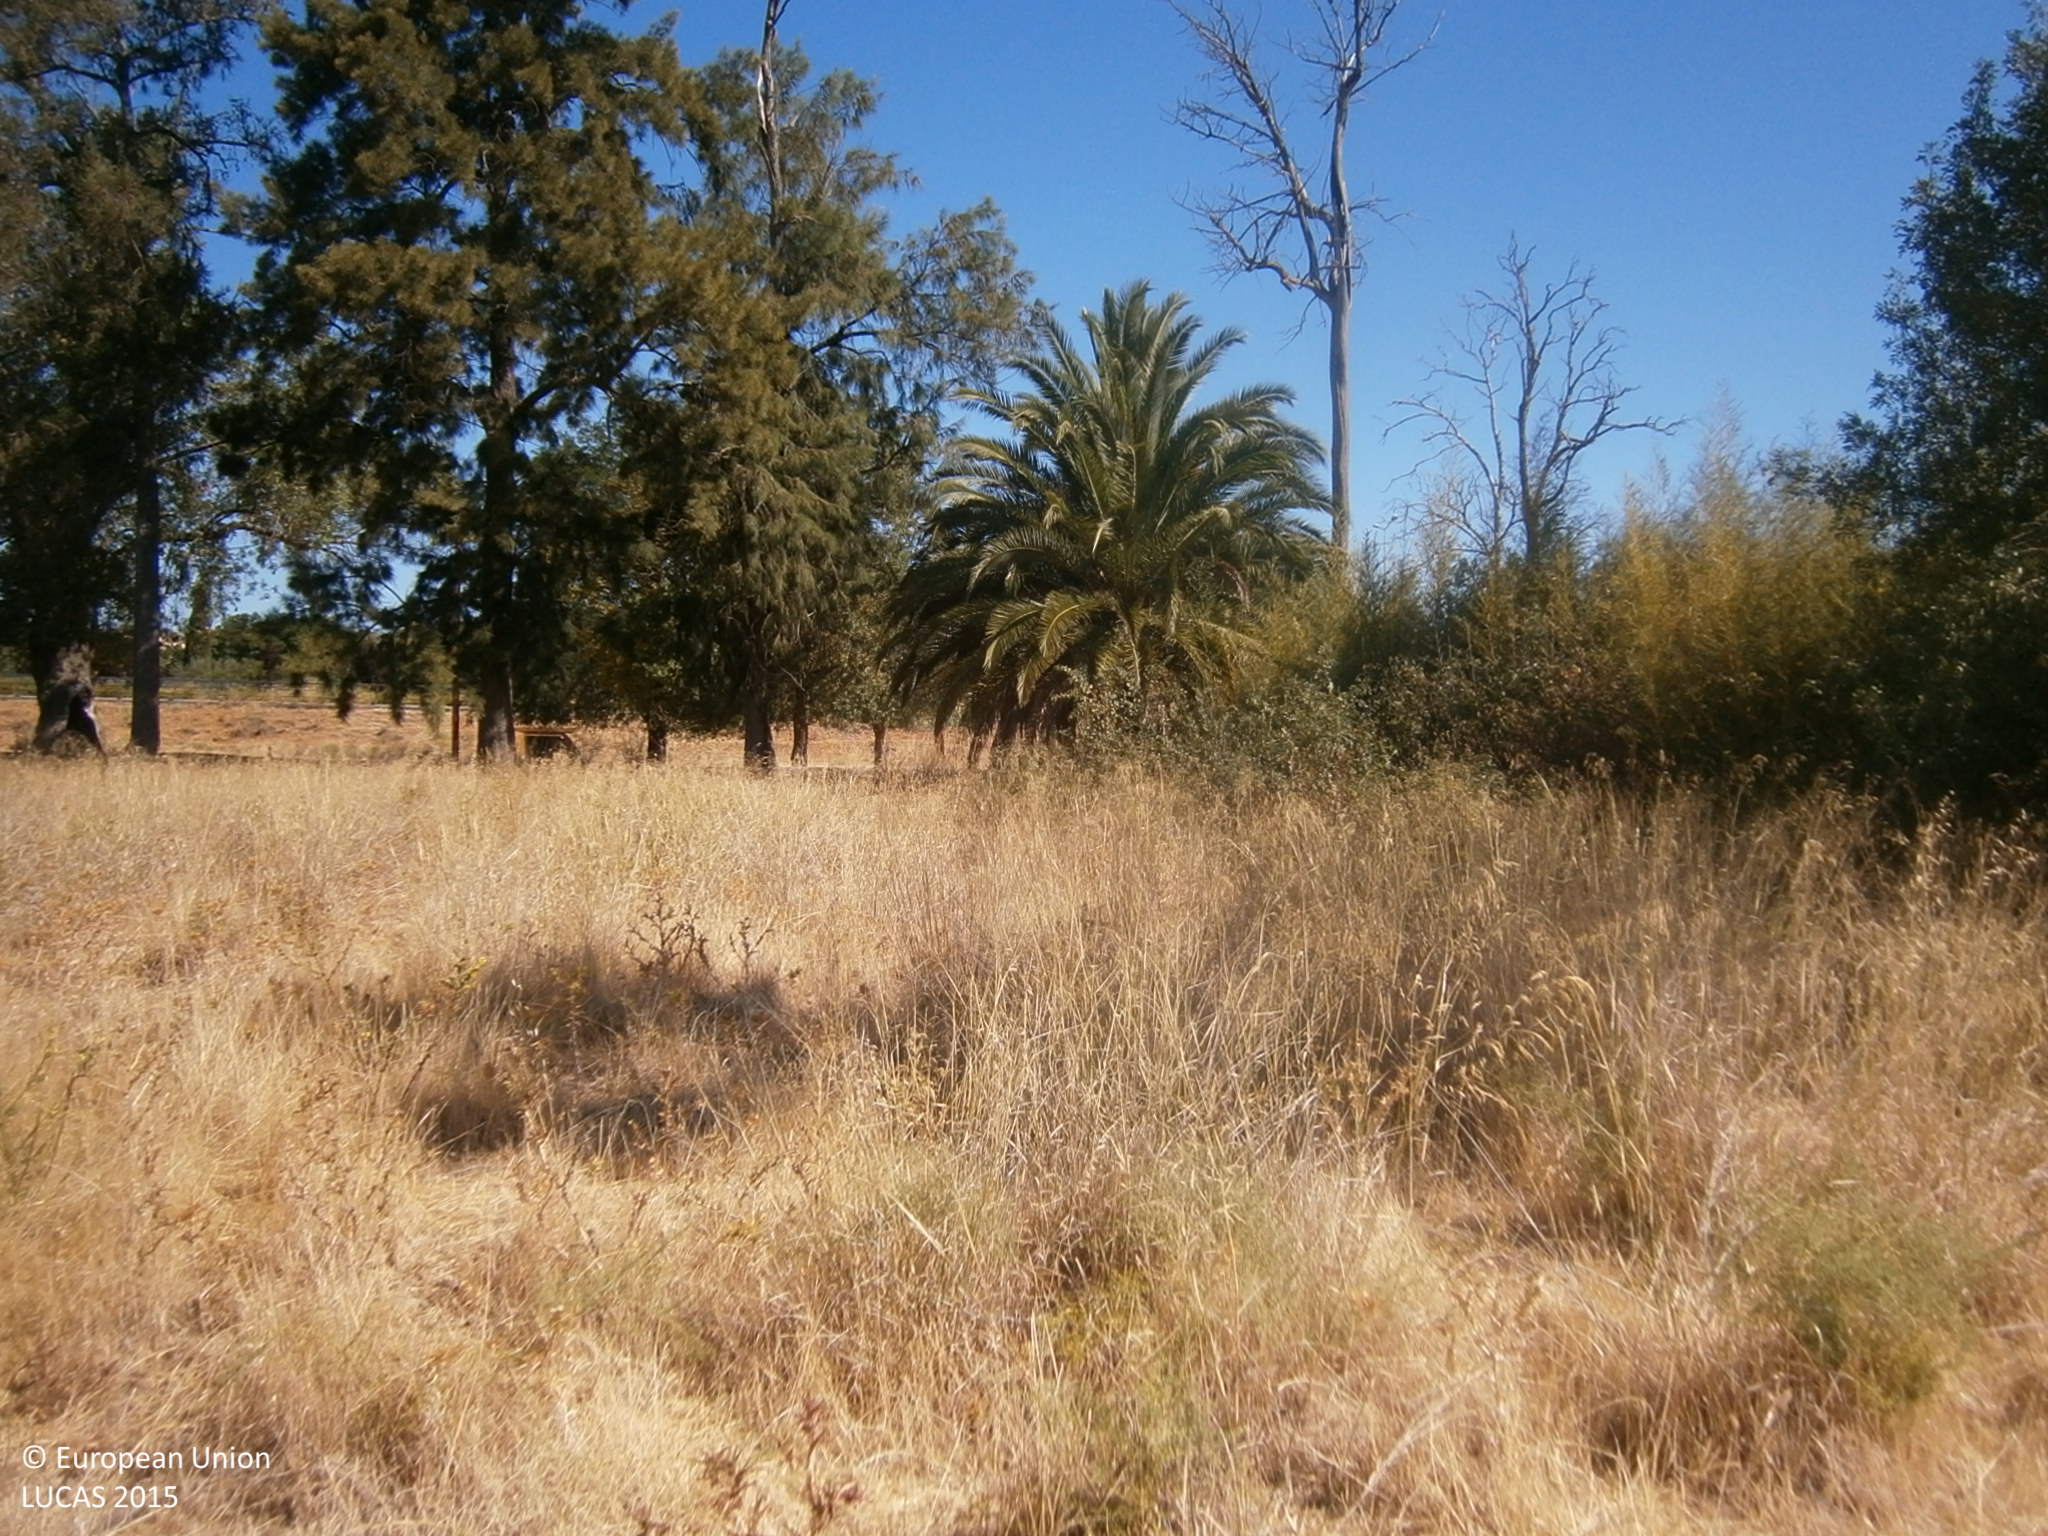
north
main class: Grassland
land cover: Grassland with sparse tree/shrub cover
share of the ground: > 75 %
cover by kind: herbaceous plants 90 %, coniferous forest trees 5 %, shrubs 5 %
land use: Agriculture (excluding fallow land and kitchen gardens)
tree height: > 5 m
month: July
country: ES
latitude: 38.8813
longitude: -7.0044
